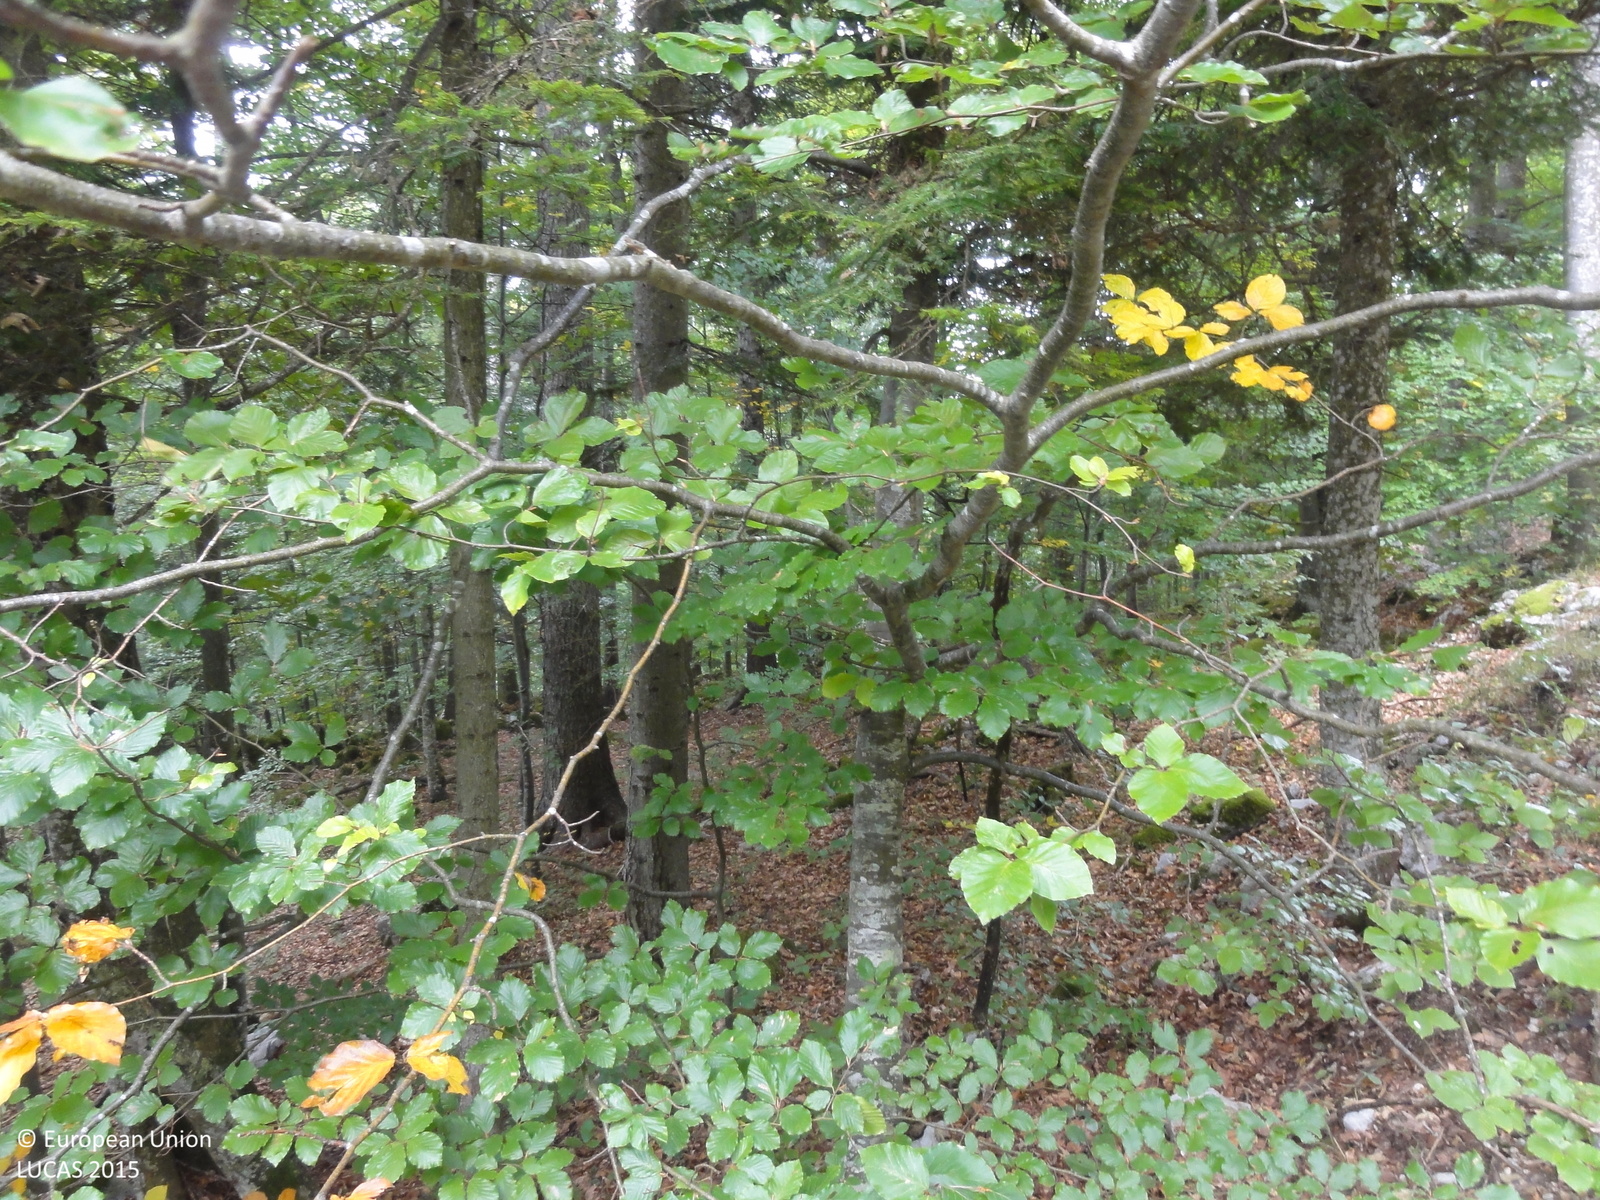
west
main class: Woodland
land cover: Spruce dominated mixed woodland
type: mountainous beech forest
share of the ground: > 75 %
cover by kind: broadleaved forest trees 45 %, coniferous forest trees 40 %, unconsolidated bare surface 10 %, herbaceous plants 5 %
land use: Forestry
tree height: > 5 m
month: September
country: SI
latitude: 45.6189
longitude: 15.0361
